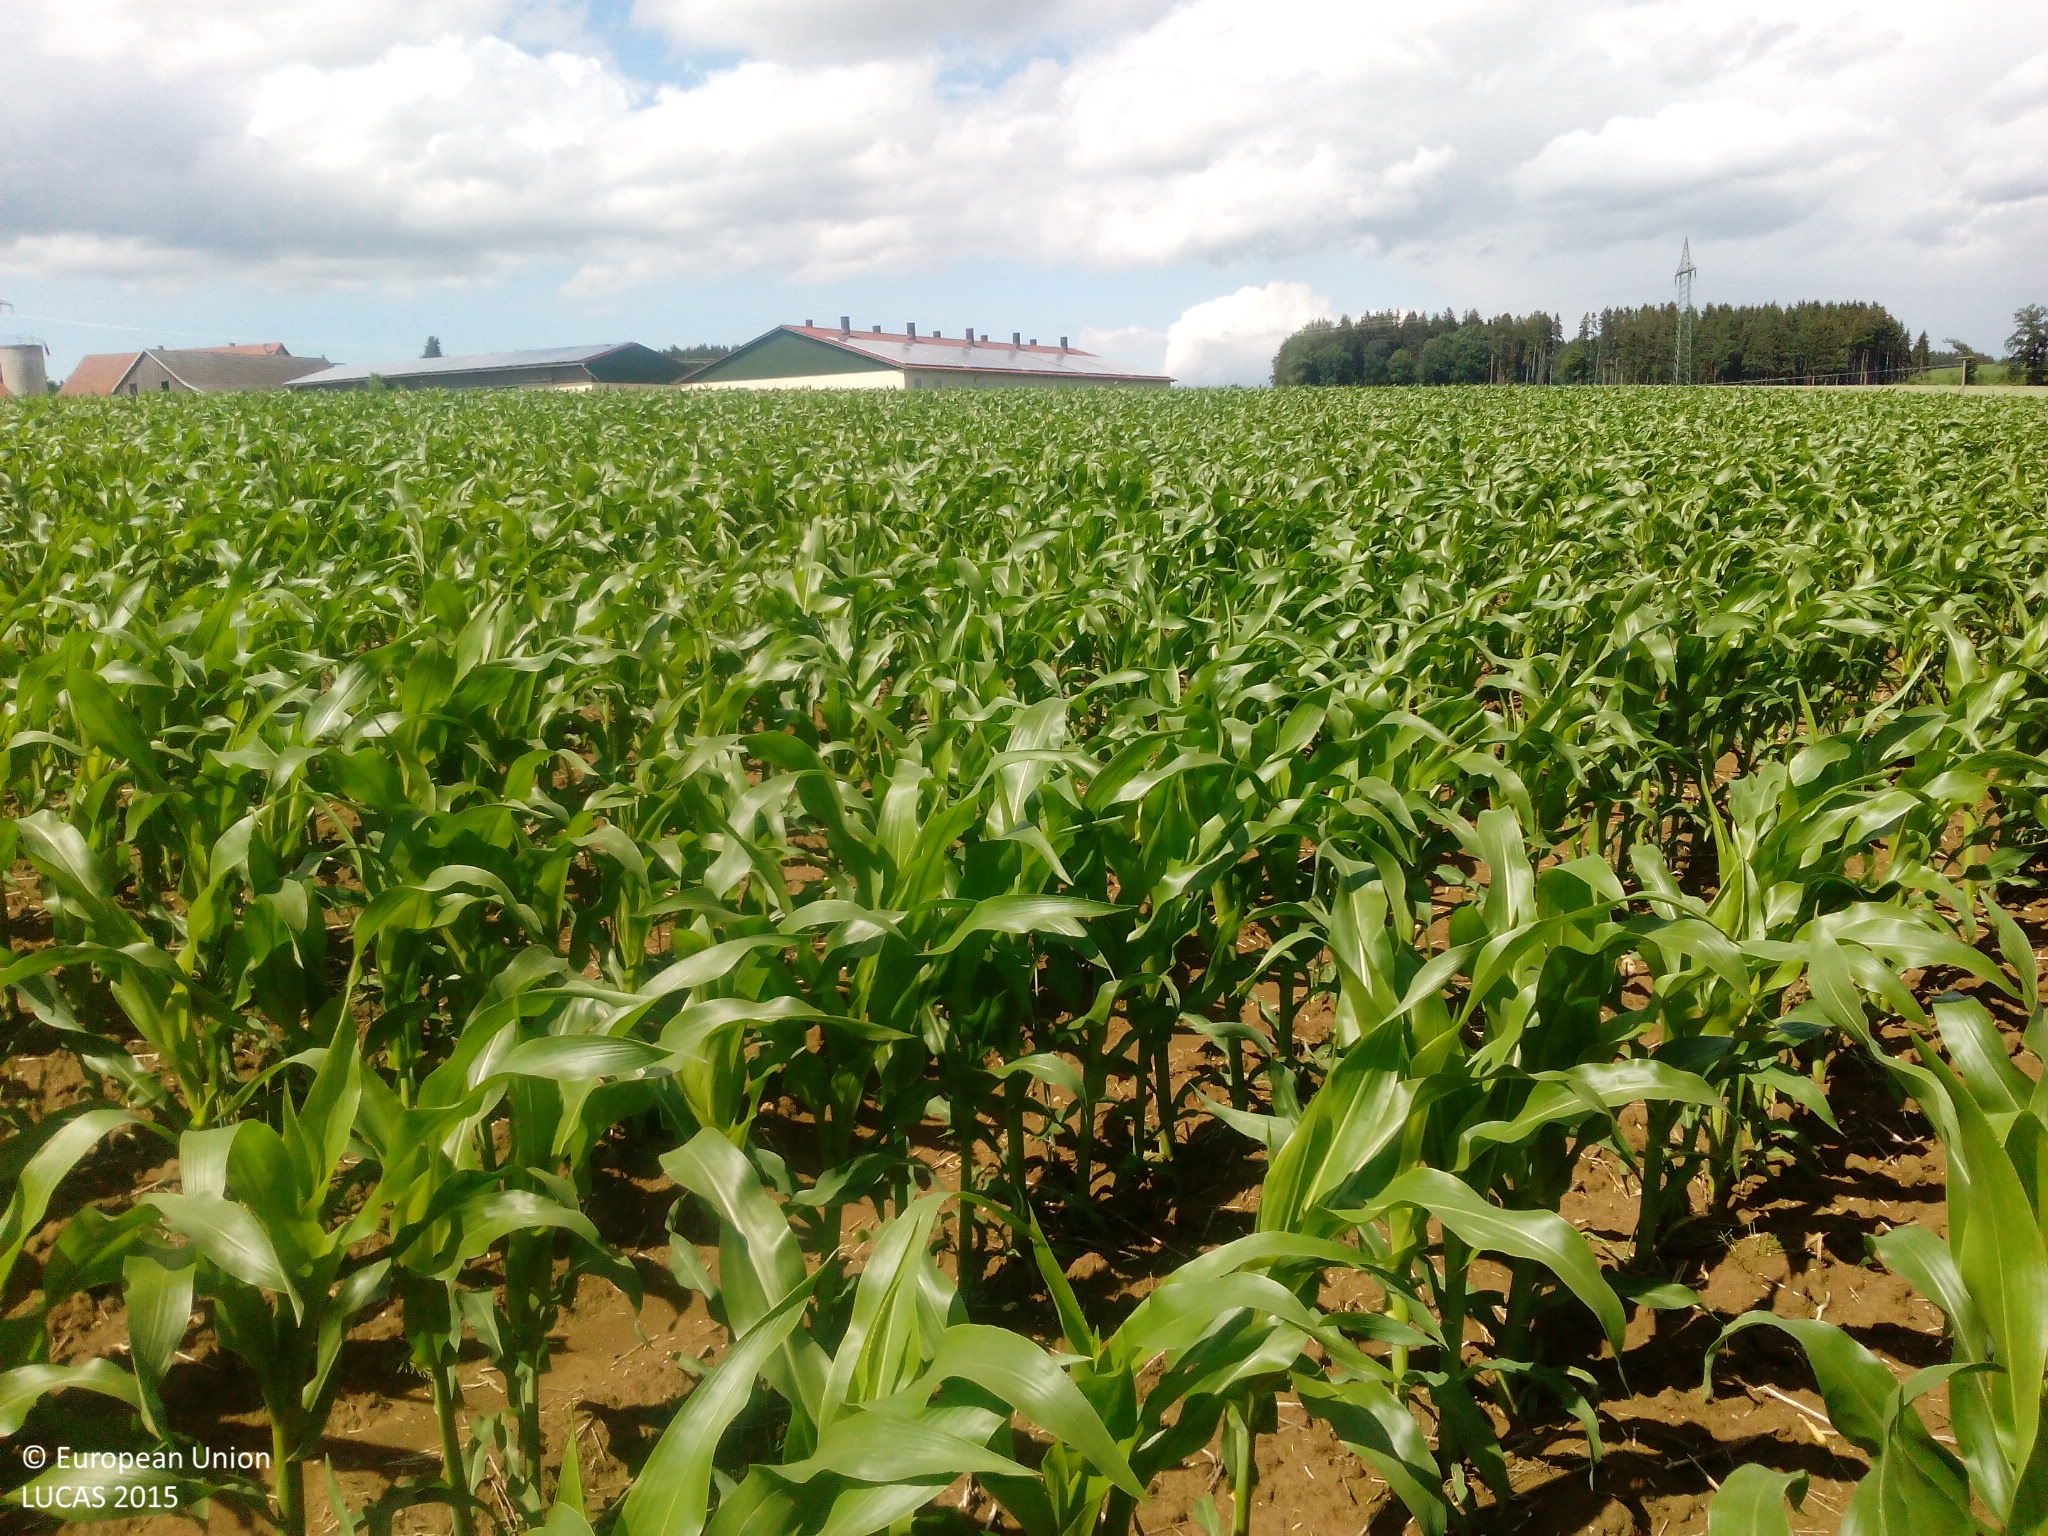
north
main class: Cropland
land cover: Maize
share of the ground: 25 - 50 %
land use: Agriculture (excluding fallow land and kitchen gardens)
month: June
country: DE
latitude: 48.6029
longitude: 11.9114
